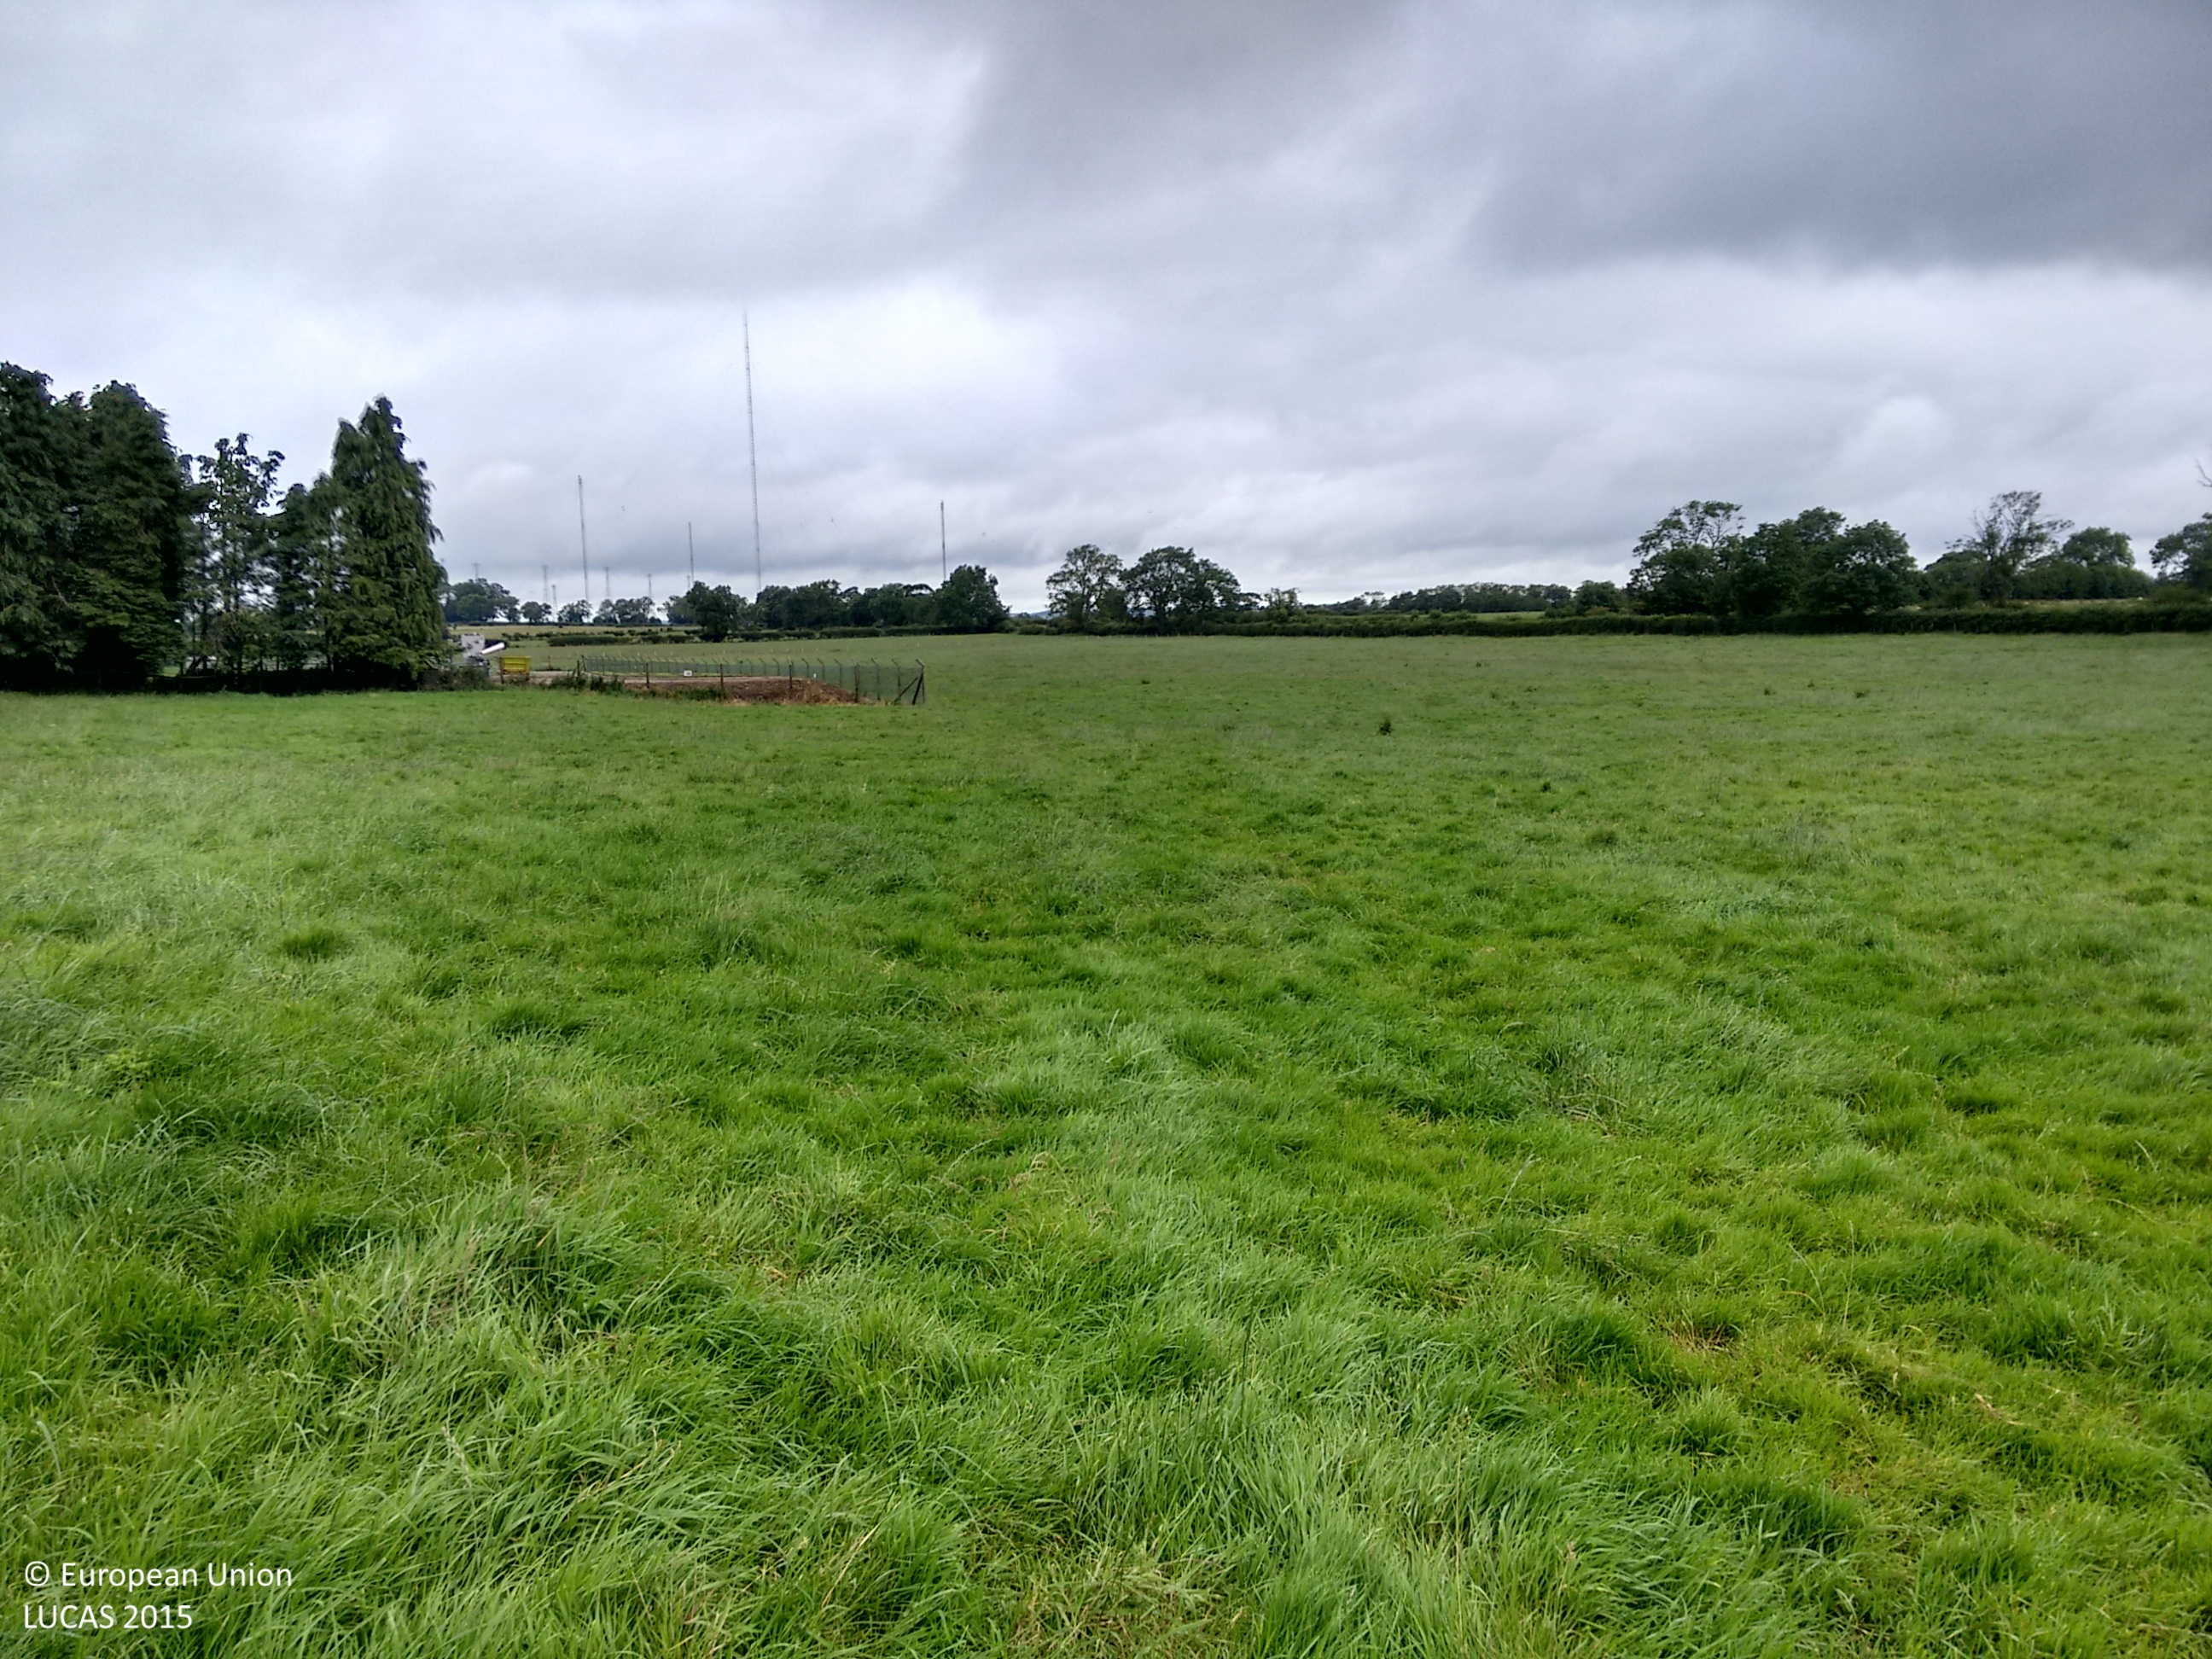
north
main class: Grassland
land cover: Grassland without tree/shrub cover
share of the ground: > 75 %
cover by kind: herbaceous plants 100 %
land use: Agriculture (excluding fallow land and kitchen gardens)
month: August
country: GB
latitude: 54.7152
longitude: -2.8763
